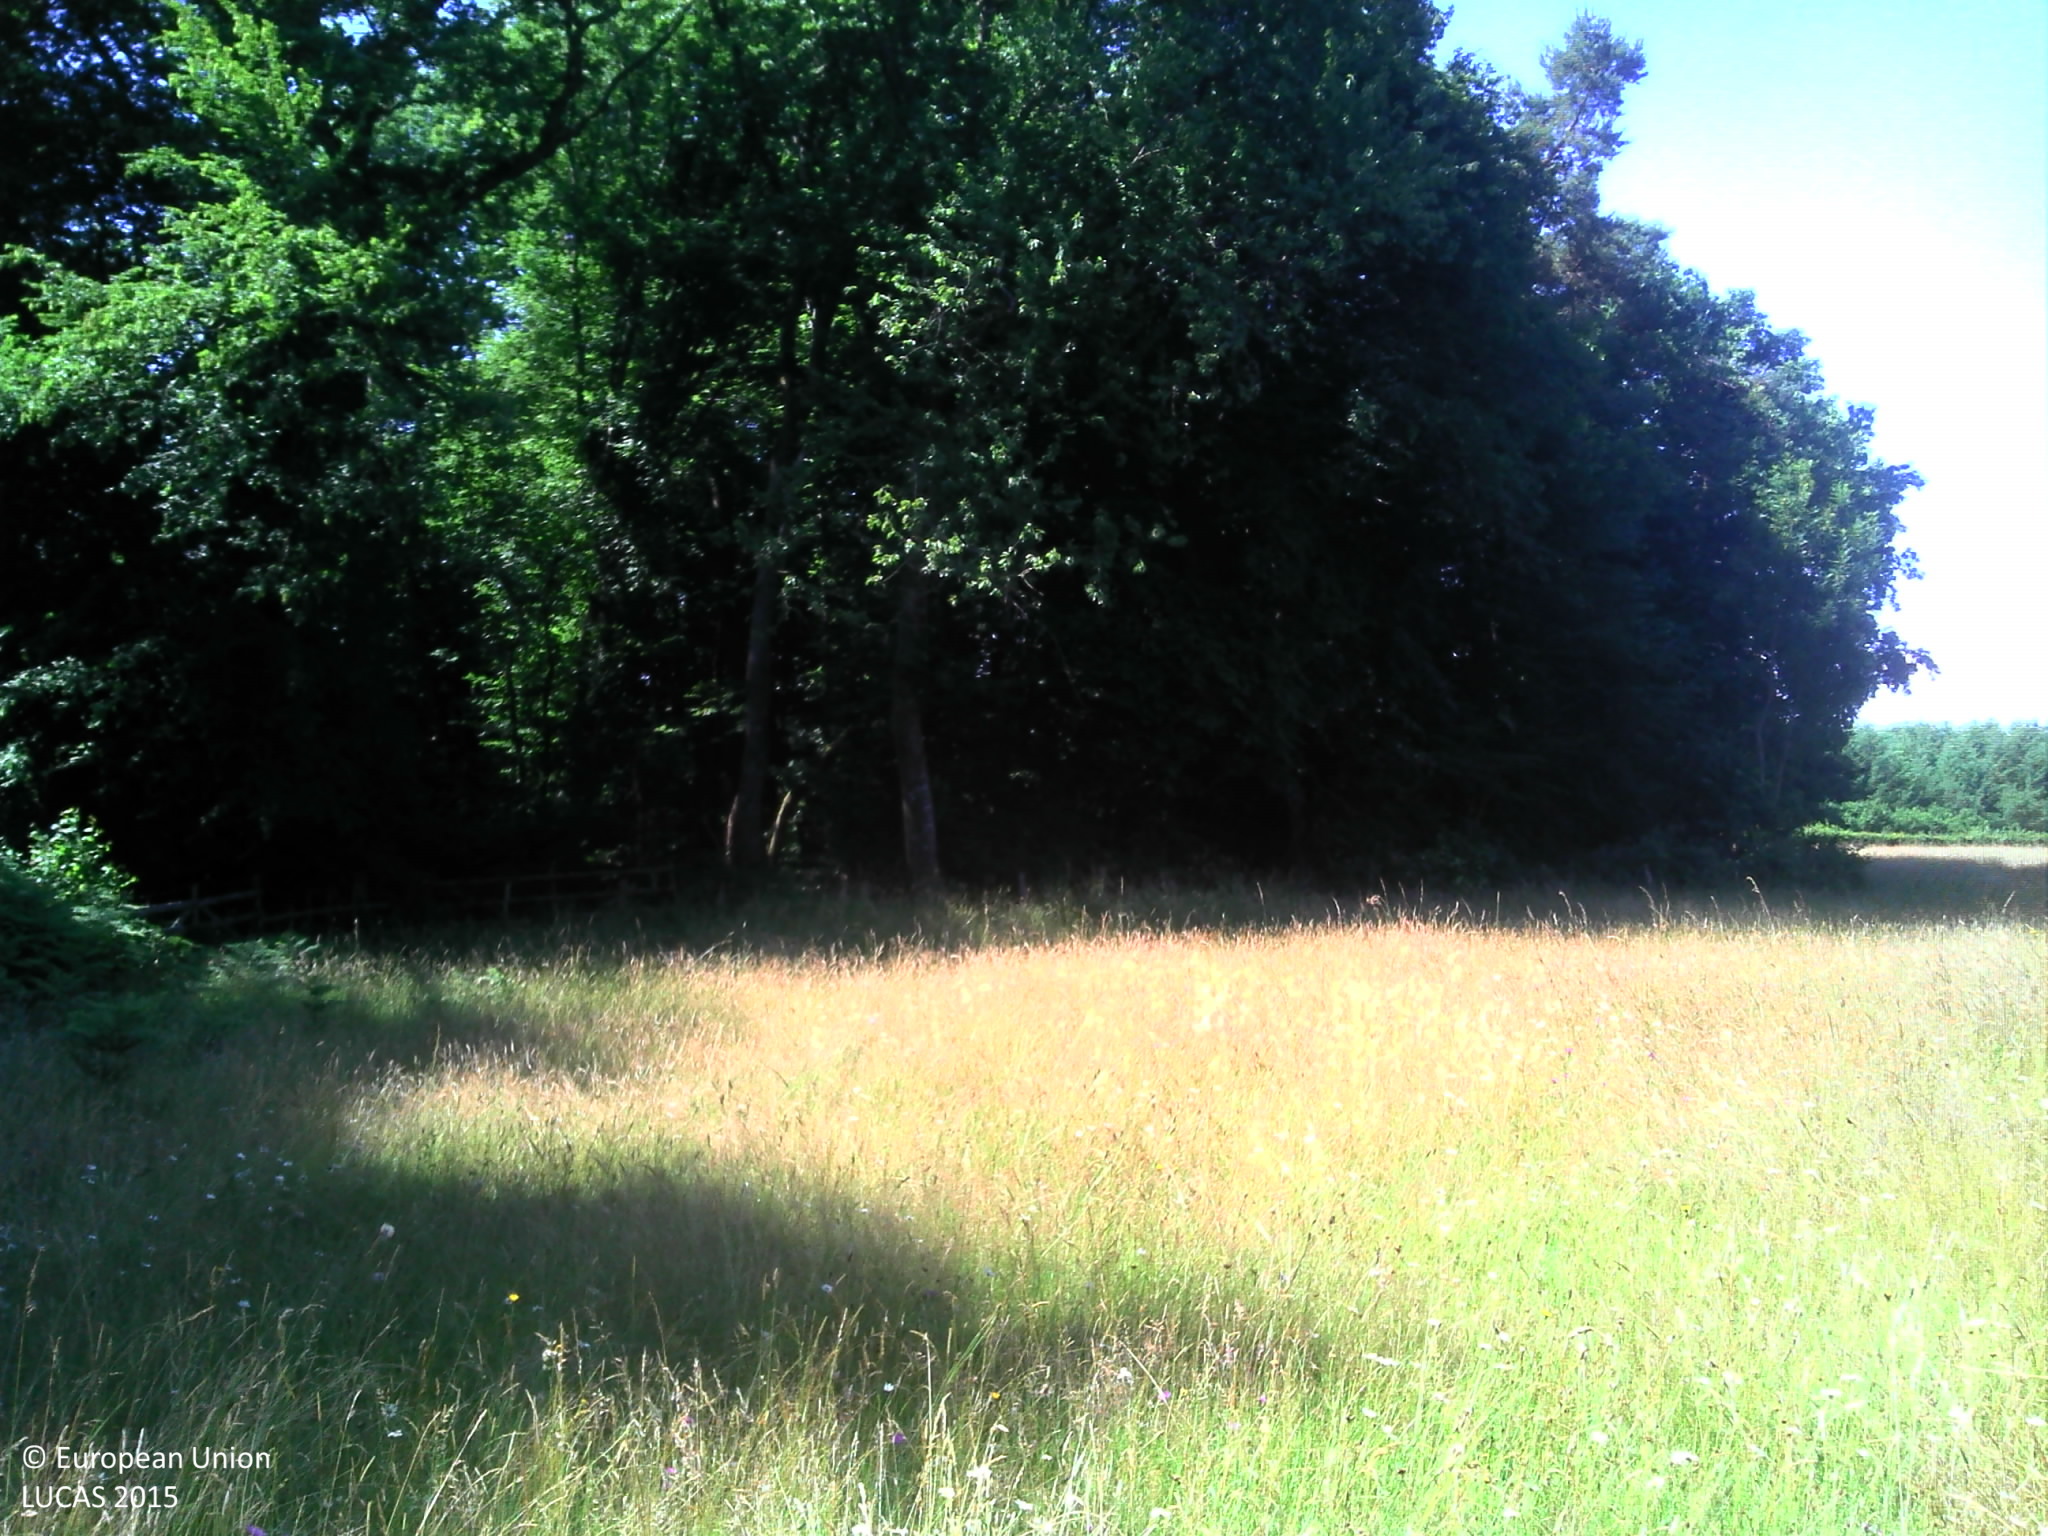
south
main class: Grassland
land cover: Grassland without tree/shrub cover
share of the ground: > 75 %
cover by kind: herbaceous plants 100 %
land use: Agriculture (excluding fallow land and kitchen gardens)
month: June
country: FR
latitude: 46.4567
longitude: 4.3896
